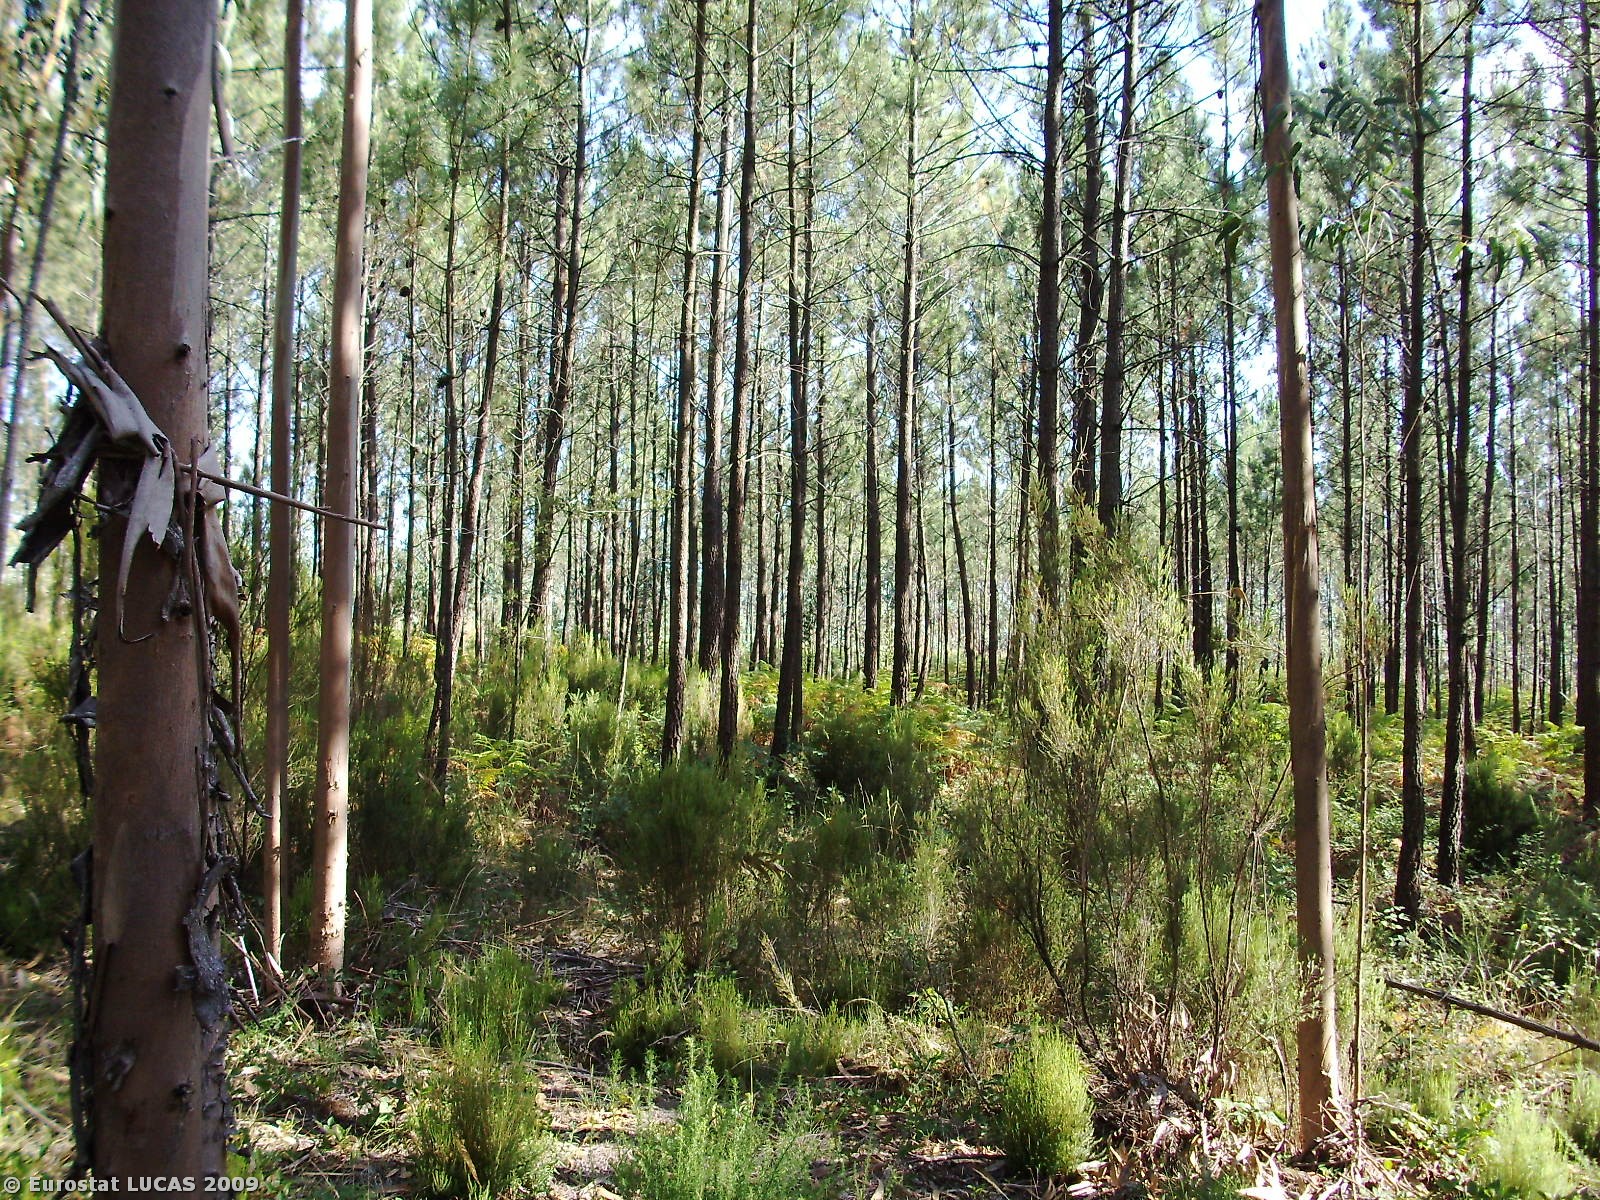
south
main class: Woodland
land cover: Broadleaved woodland
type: plantations and self-sown exotic forest
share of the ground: 50 - 75 %
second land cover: Spontaneously vegetated surfaces
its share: 25 - 50 %
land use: Forestry
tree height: > 5 m
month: July
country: PT
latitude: 39.6460
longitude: -8.9311
